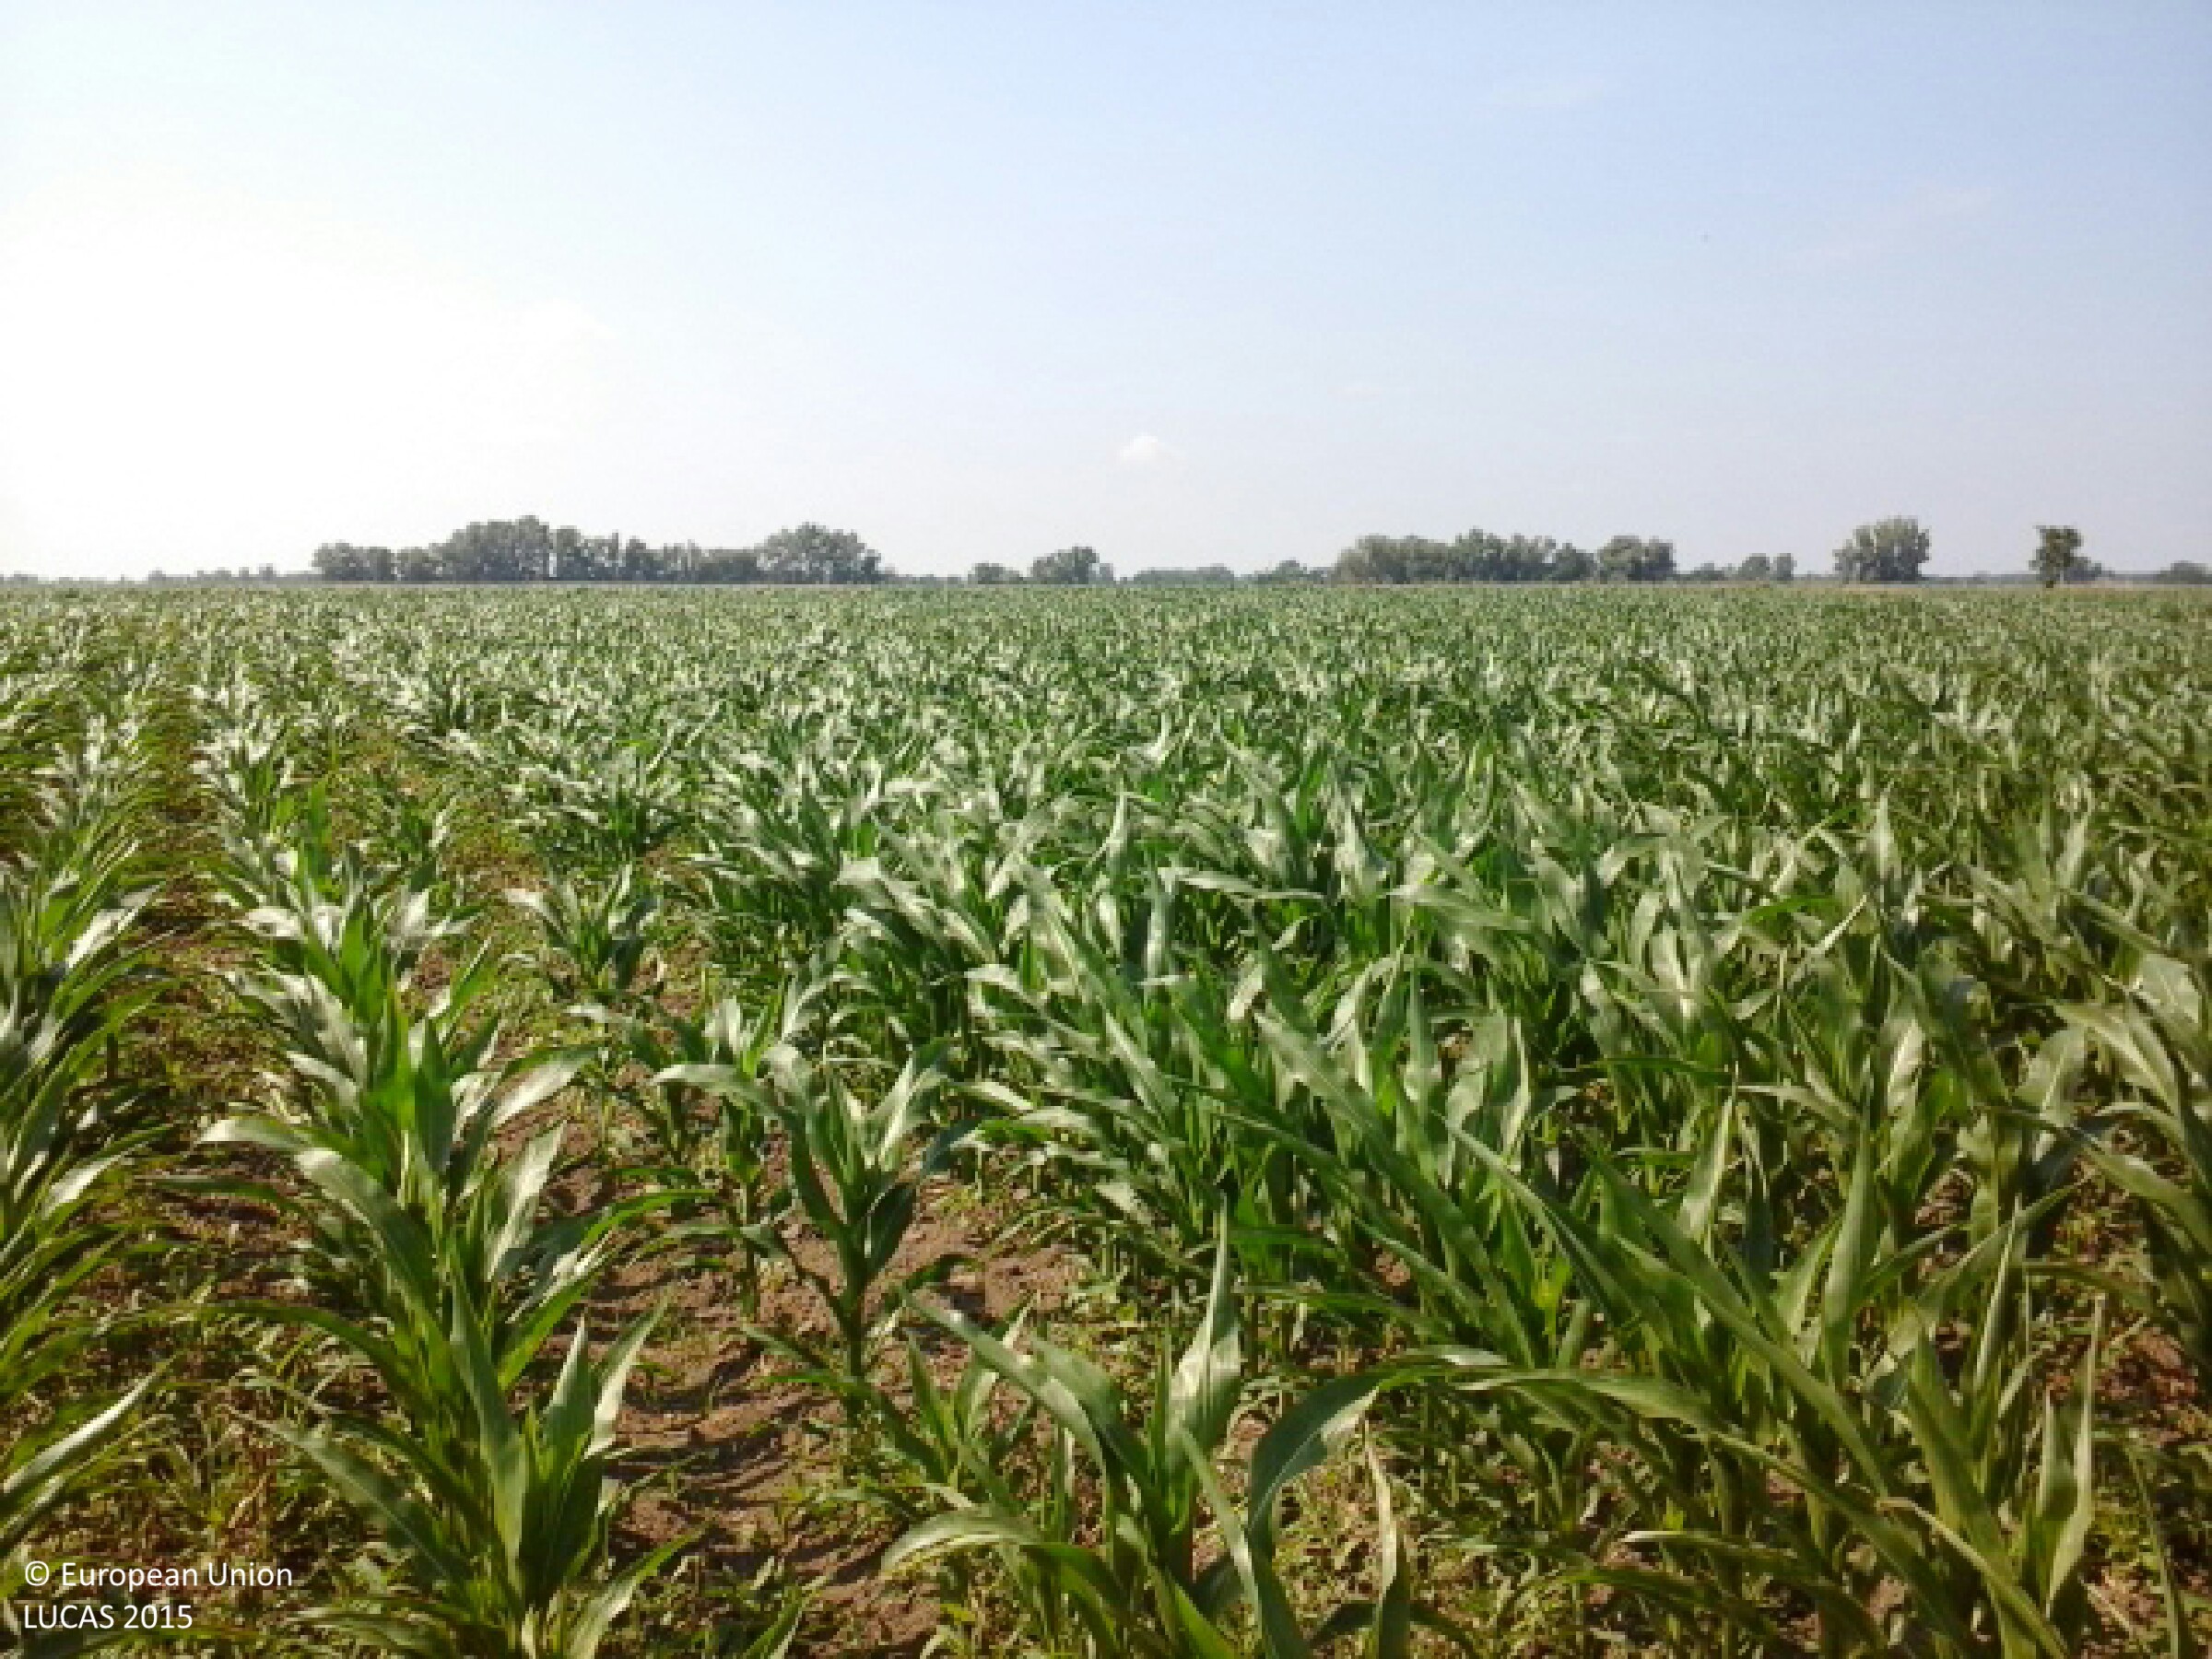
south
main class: Cropland
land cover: Maize
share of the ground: 50 - 75 %
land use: Agriculture (excluding fallow land and kitchen gardens)
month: June
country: HU
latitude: 48.2178
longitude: 21.8546
